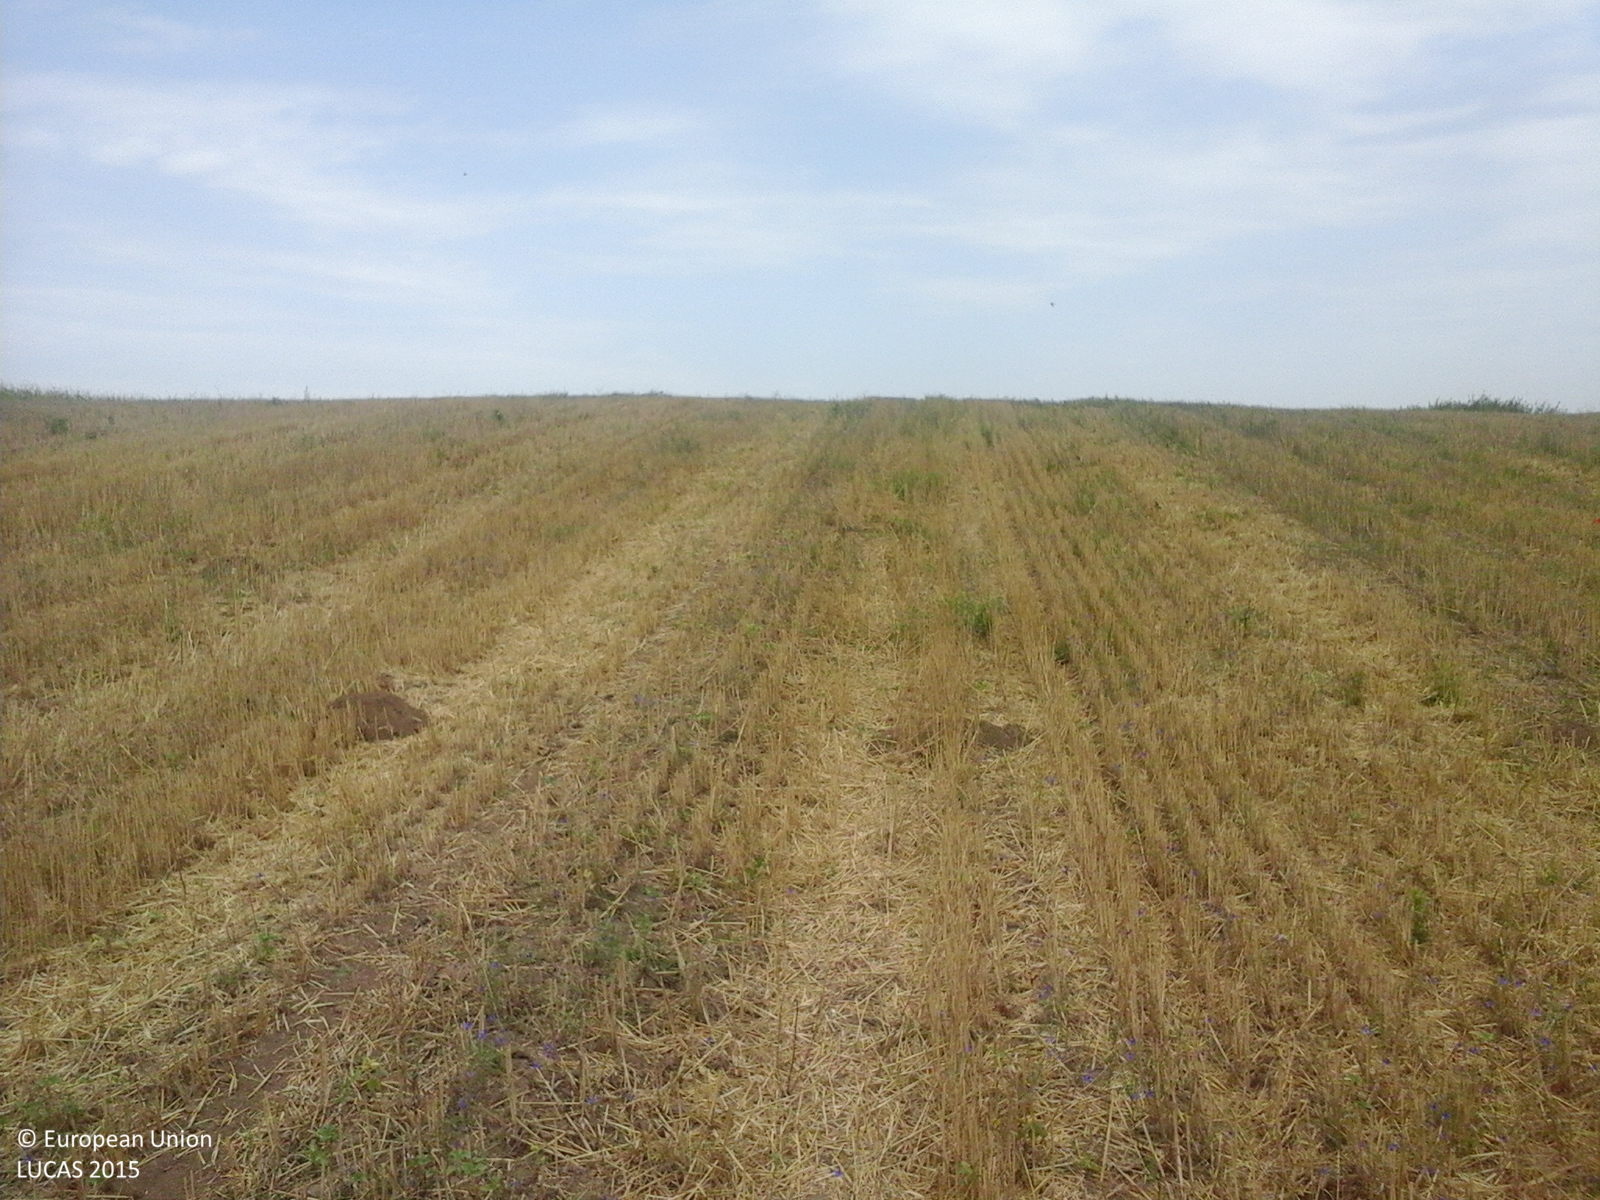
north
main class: Cropland
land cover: Common wheat
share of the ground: 25 - 50 %
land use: Agriculture (excluding fallow land and kitchen gardens)
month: August
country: RO
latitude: 43.9788
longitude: 27.7852
